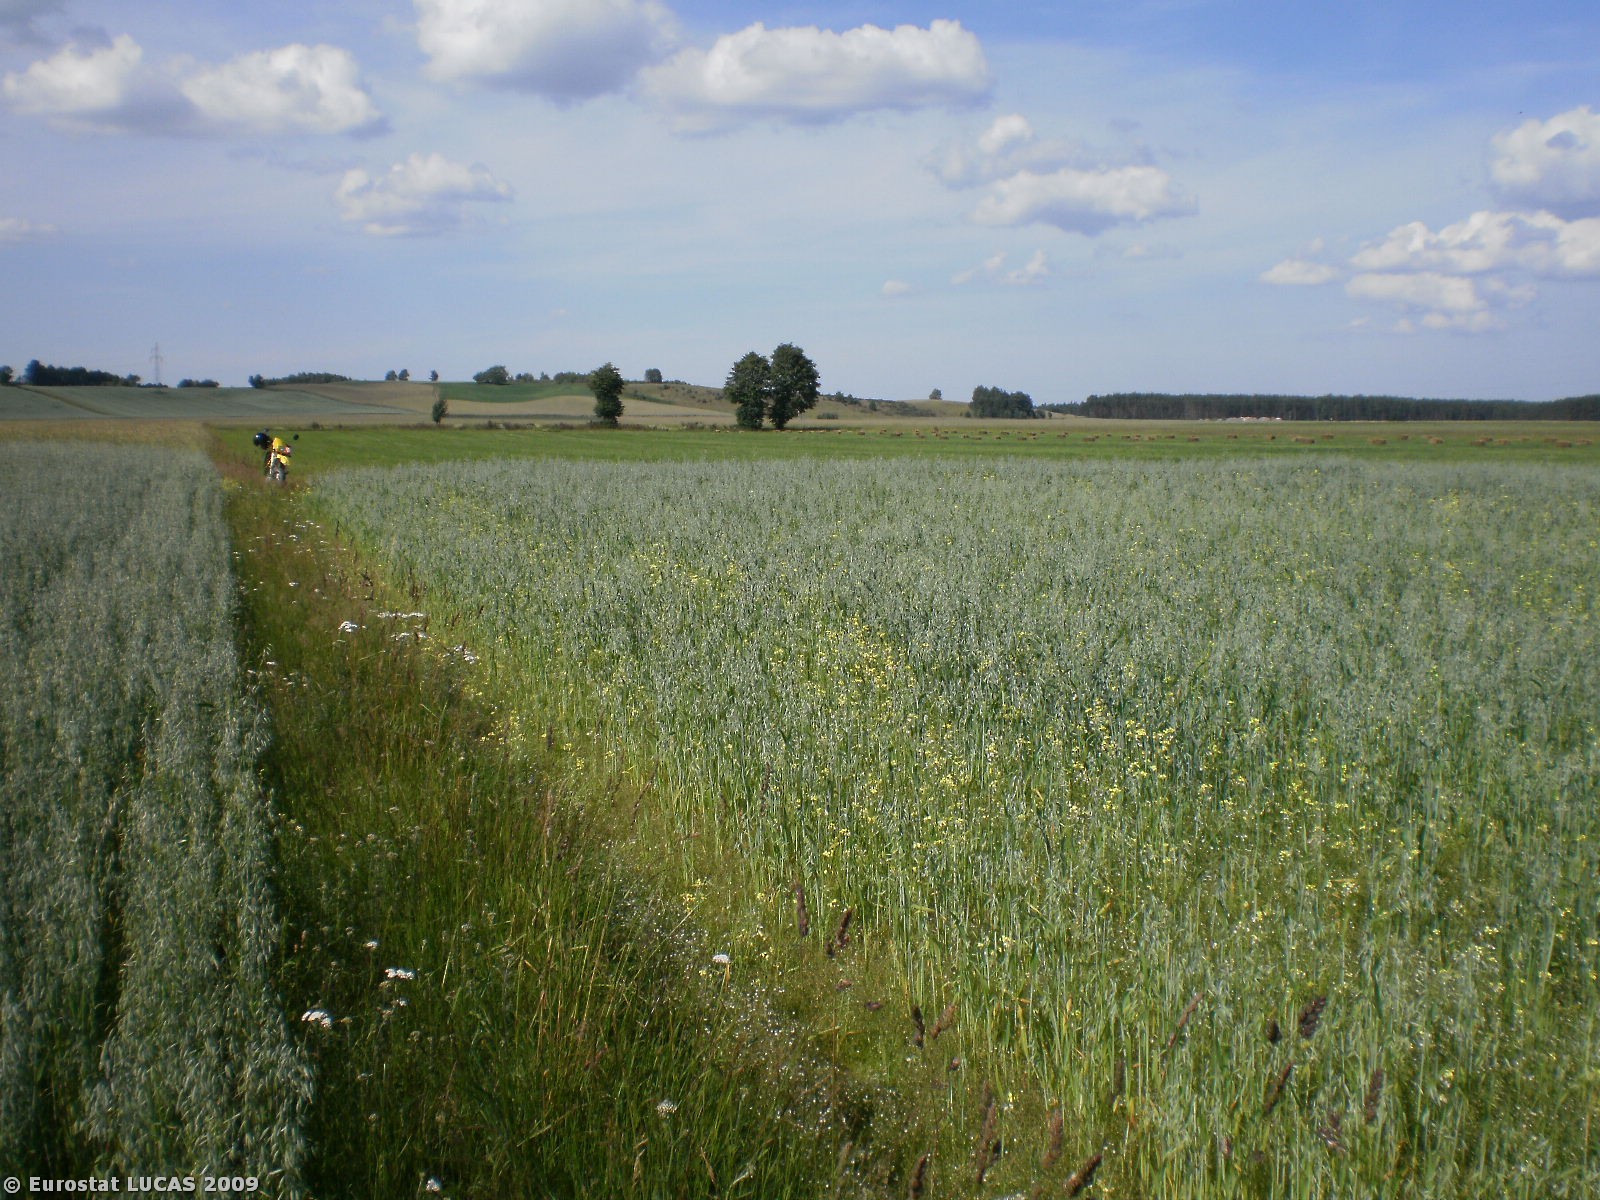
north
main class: Cropland
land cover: Oats
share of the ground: > 75 %
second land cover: Rye
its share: < 10 %
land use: Agriculture (excluding fallow land and kitchen gardens)
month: July
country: PL
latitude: 54.2089
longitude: 17.9096
